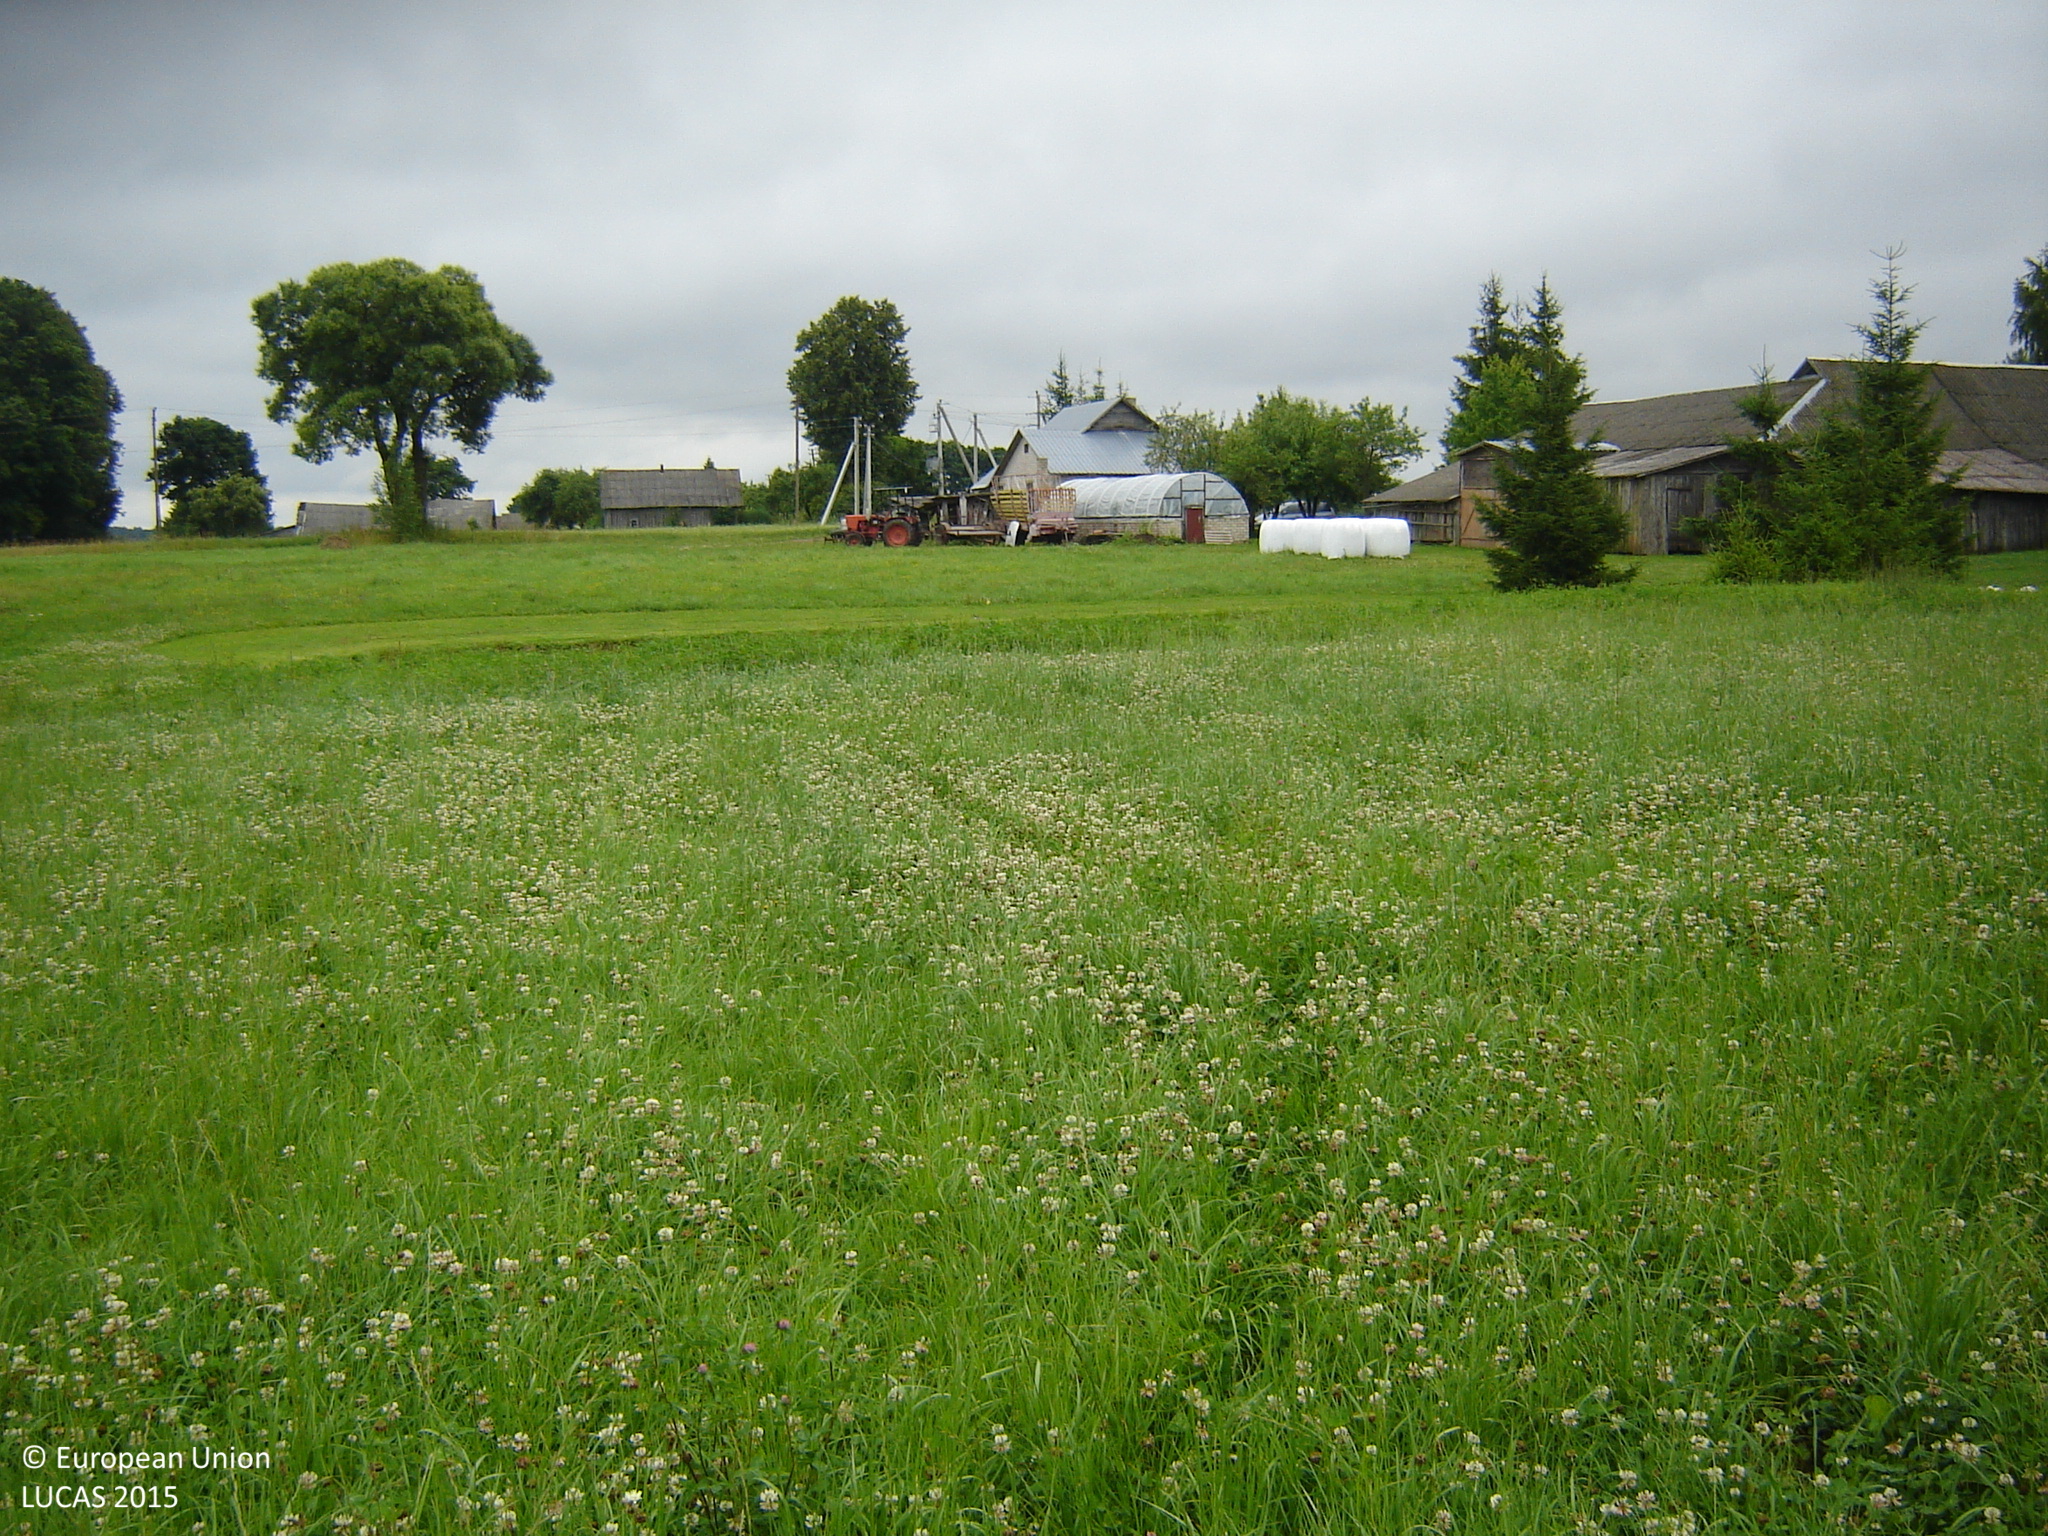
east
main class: Grassland
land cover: Grassland without tree/shrub cover
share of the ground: > 75 %
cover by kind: herbaceous plants 100 %
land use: Agriculture (excluding fallow land and kitchen gardens)
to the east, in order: Grassland without tree/shrub cover; Inland fresh water bodies; Grassland without tree/shrub cover; Artificial constructions in urban areas; Barley; Electric lines; Barley; Grass margins; Tracks; Grassland without tree/shrub cover; Barley; Shruby margins; Common wheat
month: July
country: LT
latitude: 55.3467
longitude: 25.2088
